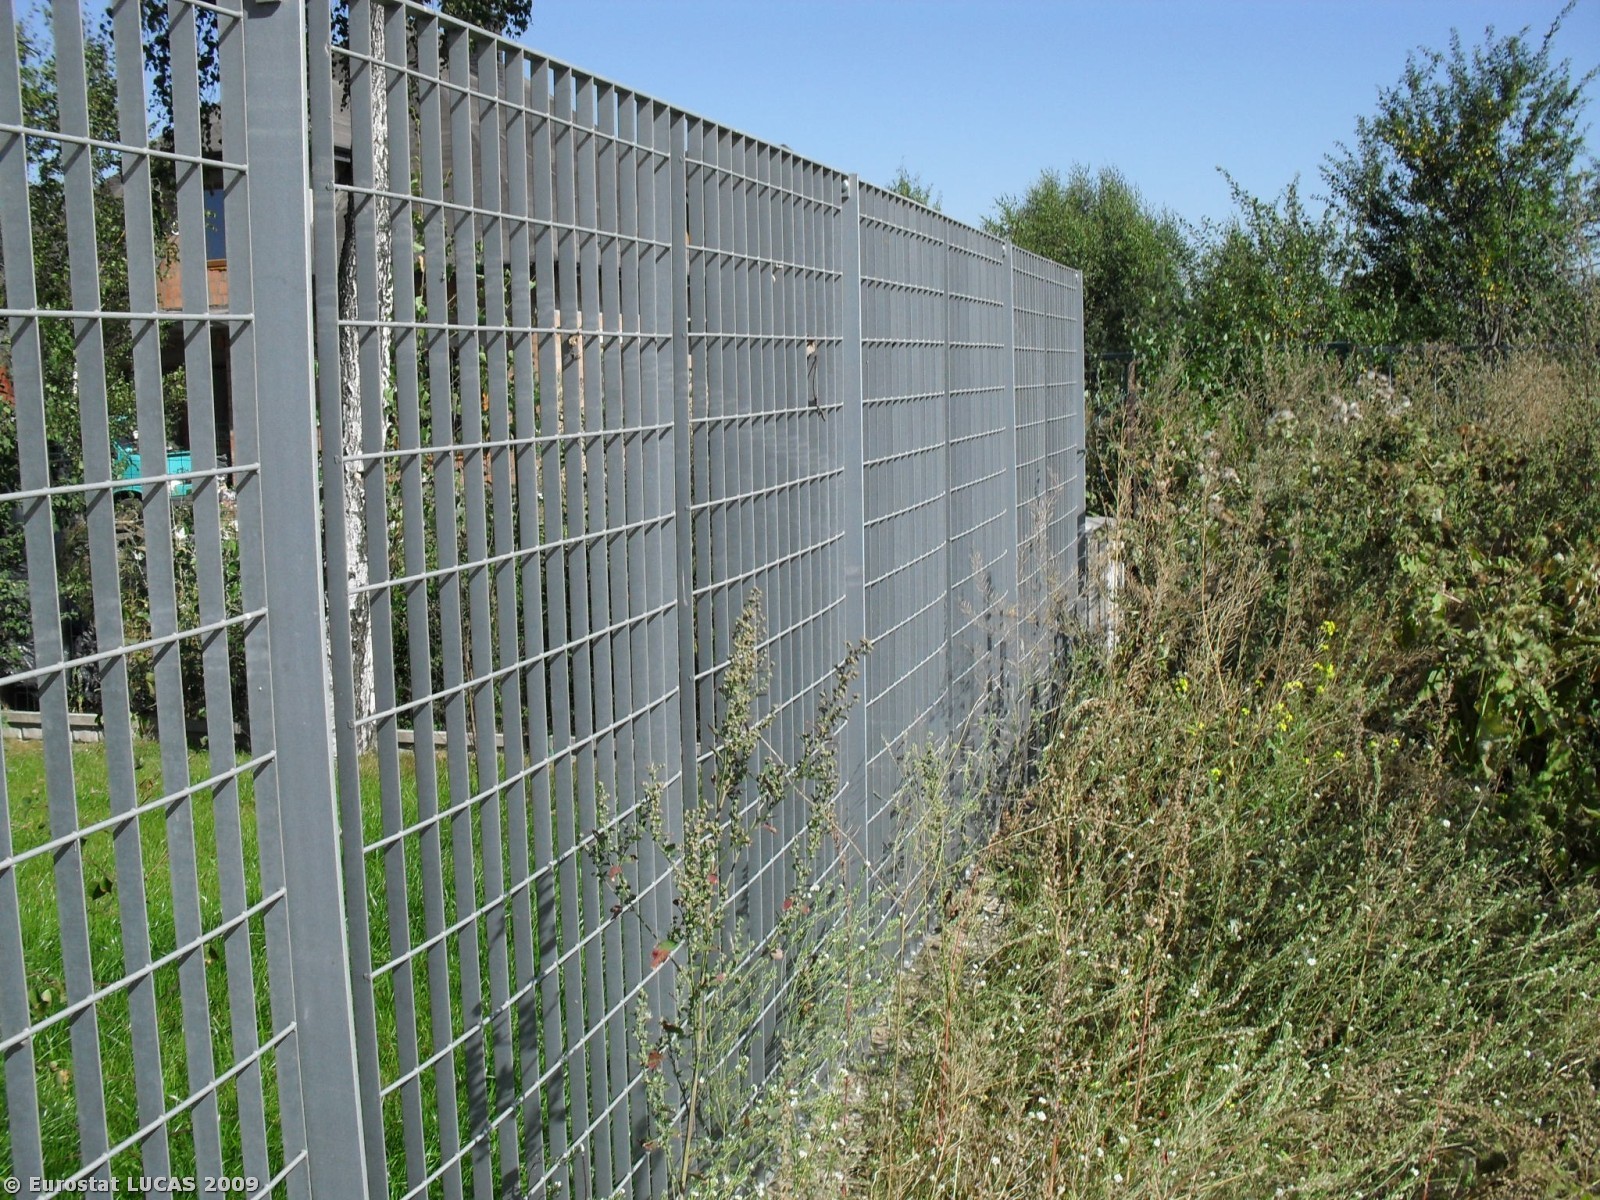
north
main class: Grassland
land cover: Grassland with sparse tree/shrub cover
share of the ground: > 75 %
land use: Residential
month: August
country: PL
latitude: 51.6769
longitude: 19.4127
